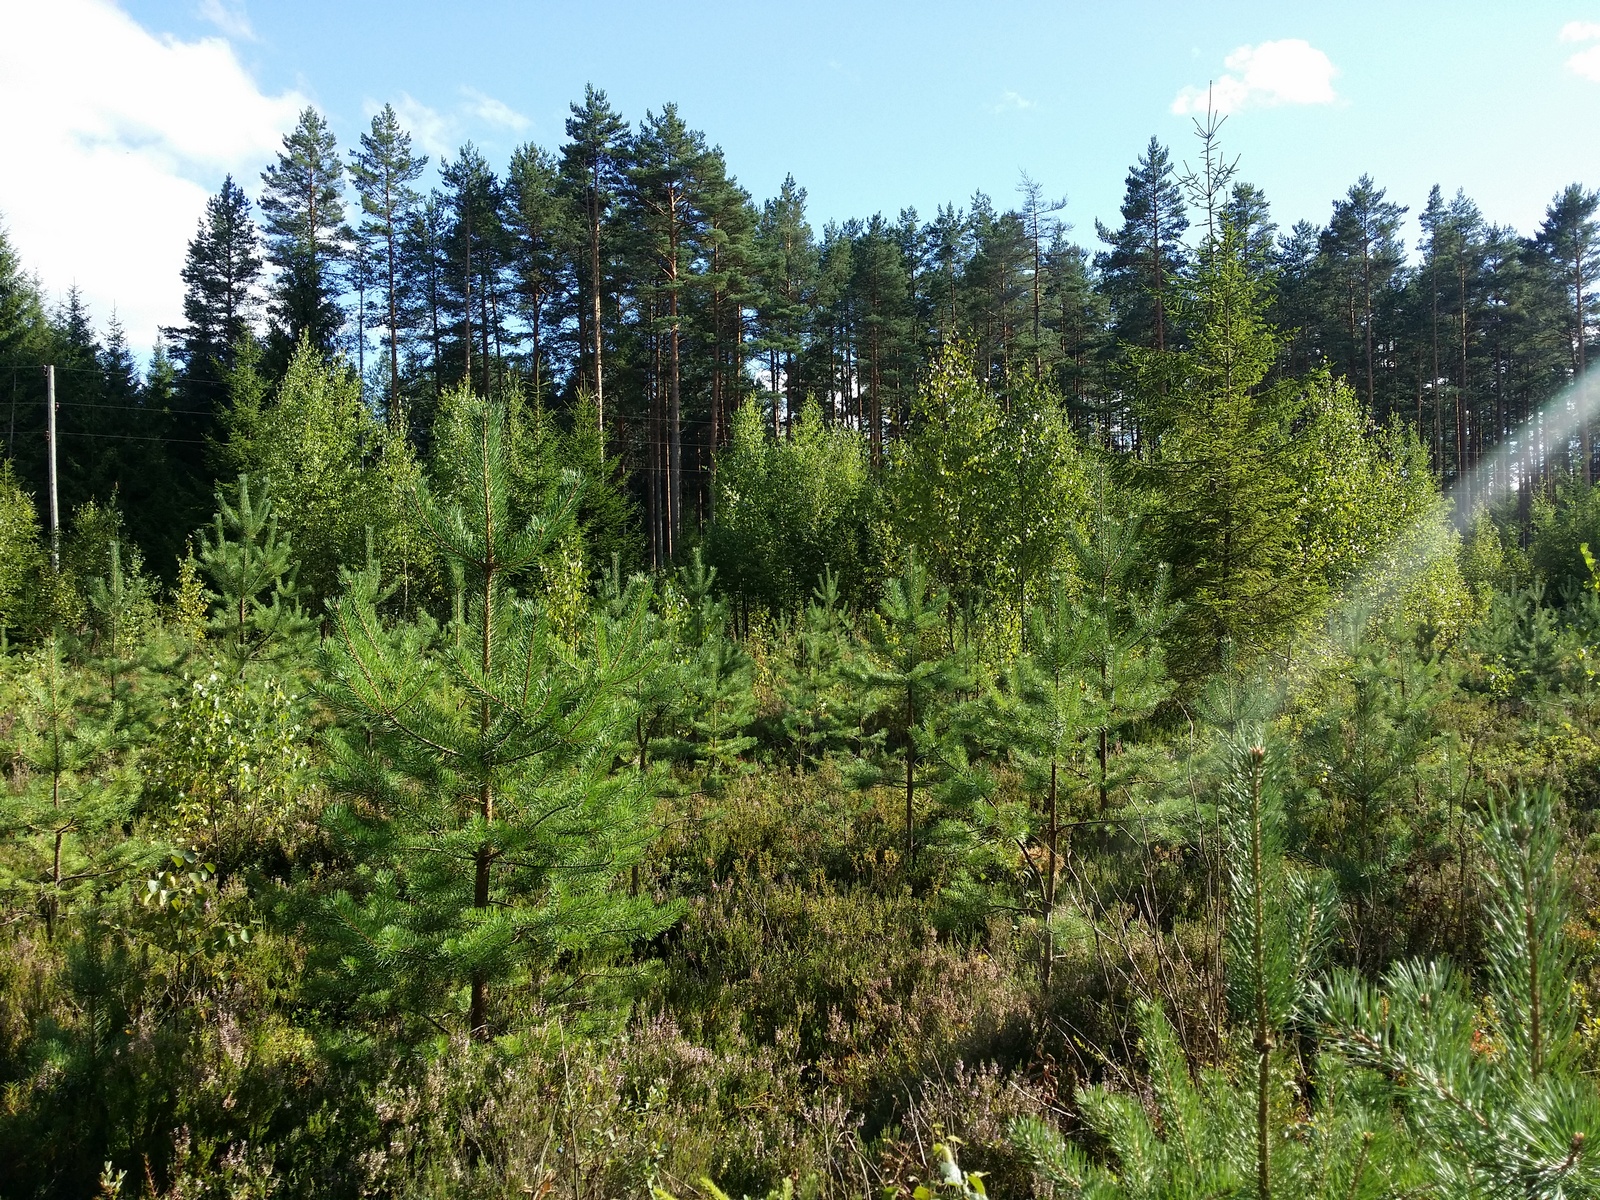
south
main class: Woodland
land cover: Other mixed woodland
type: hemiboreal forest and nemoral coniferous forest and mixed broadleaved-coniferous forest
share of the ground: 25 - 50 %
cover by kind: lichens and mosses 50 %, broadleaved forest trees 25 %, coniferous forest trees 15 %, herbaceous plants 10 %
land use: Forestry
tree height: < 5 m
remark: Nursery
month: August
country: LV
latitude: 57.2643
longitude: 27.6048
